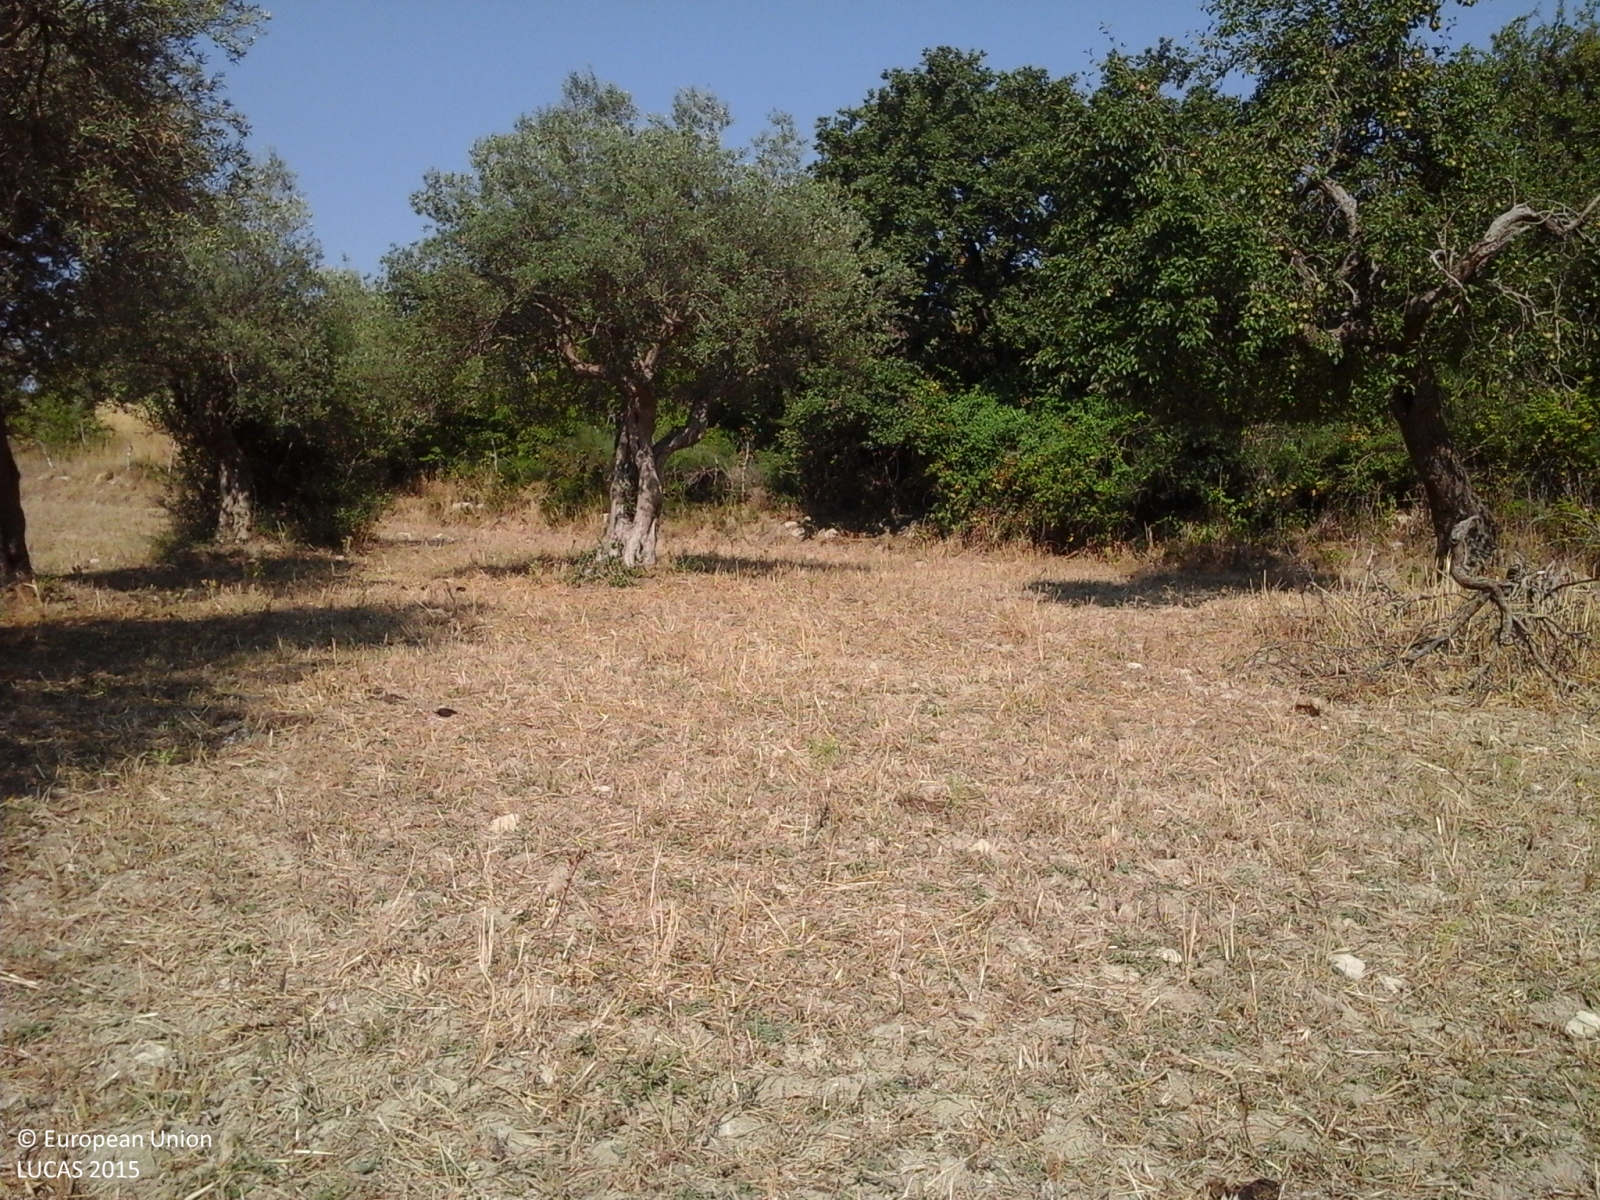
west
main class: Cropland
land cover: Mixed cereals for fodder
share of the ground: > 75 %
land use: Agriculture (excluding fallow land and kitchen gardens)
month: July
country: IT
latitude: 37.0585
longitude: 14.8766
